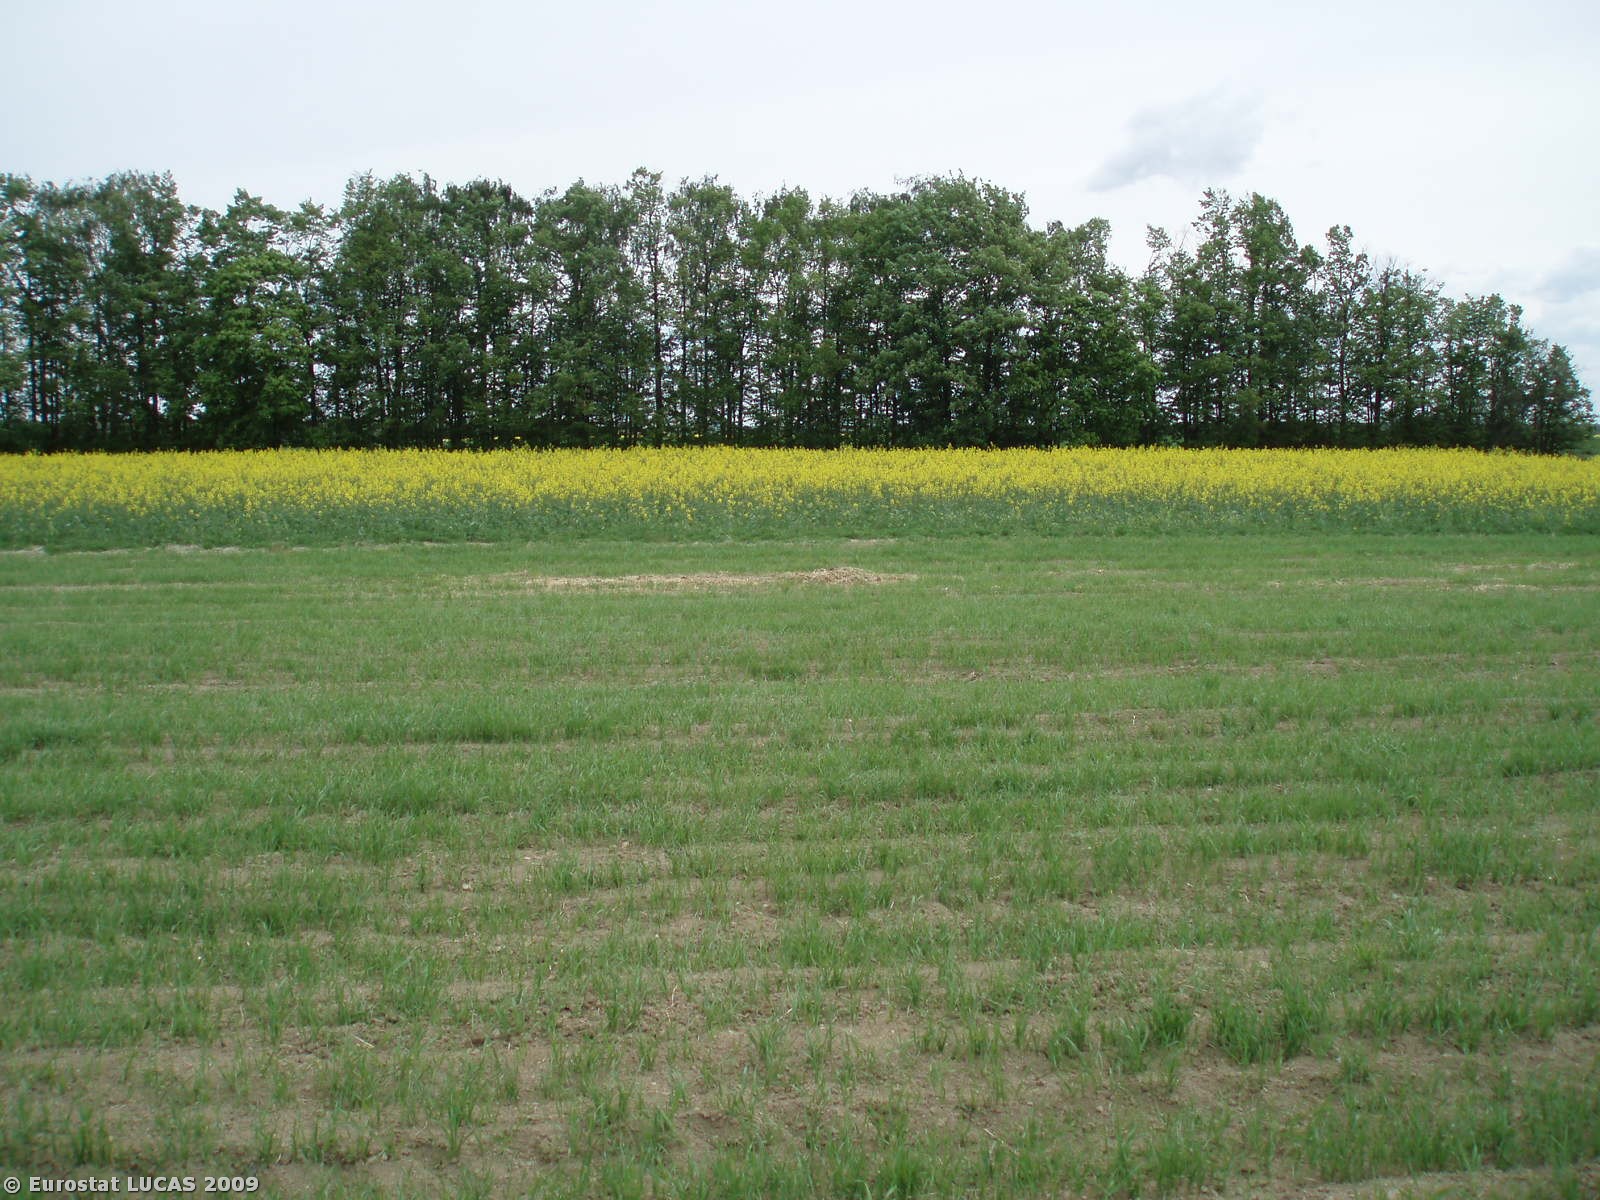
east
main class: Cropland
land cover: Common wheat
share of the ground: 50 - 75 %
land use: Agriculture (excluding fallow land and kitchen gardens)
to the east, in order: Common wheat; Ditches and canals; Rape and turnip rape; Grass margins; Broadleaved woodland; Grass margins; Tracks; Barley
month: May
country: CZ
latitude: 50.1086
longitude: 14.1540
